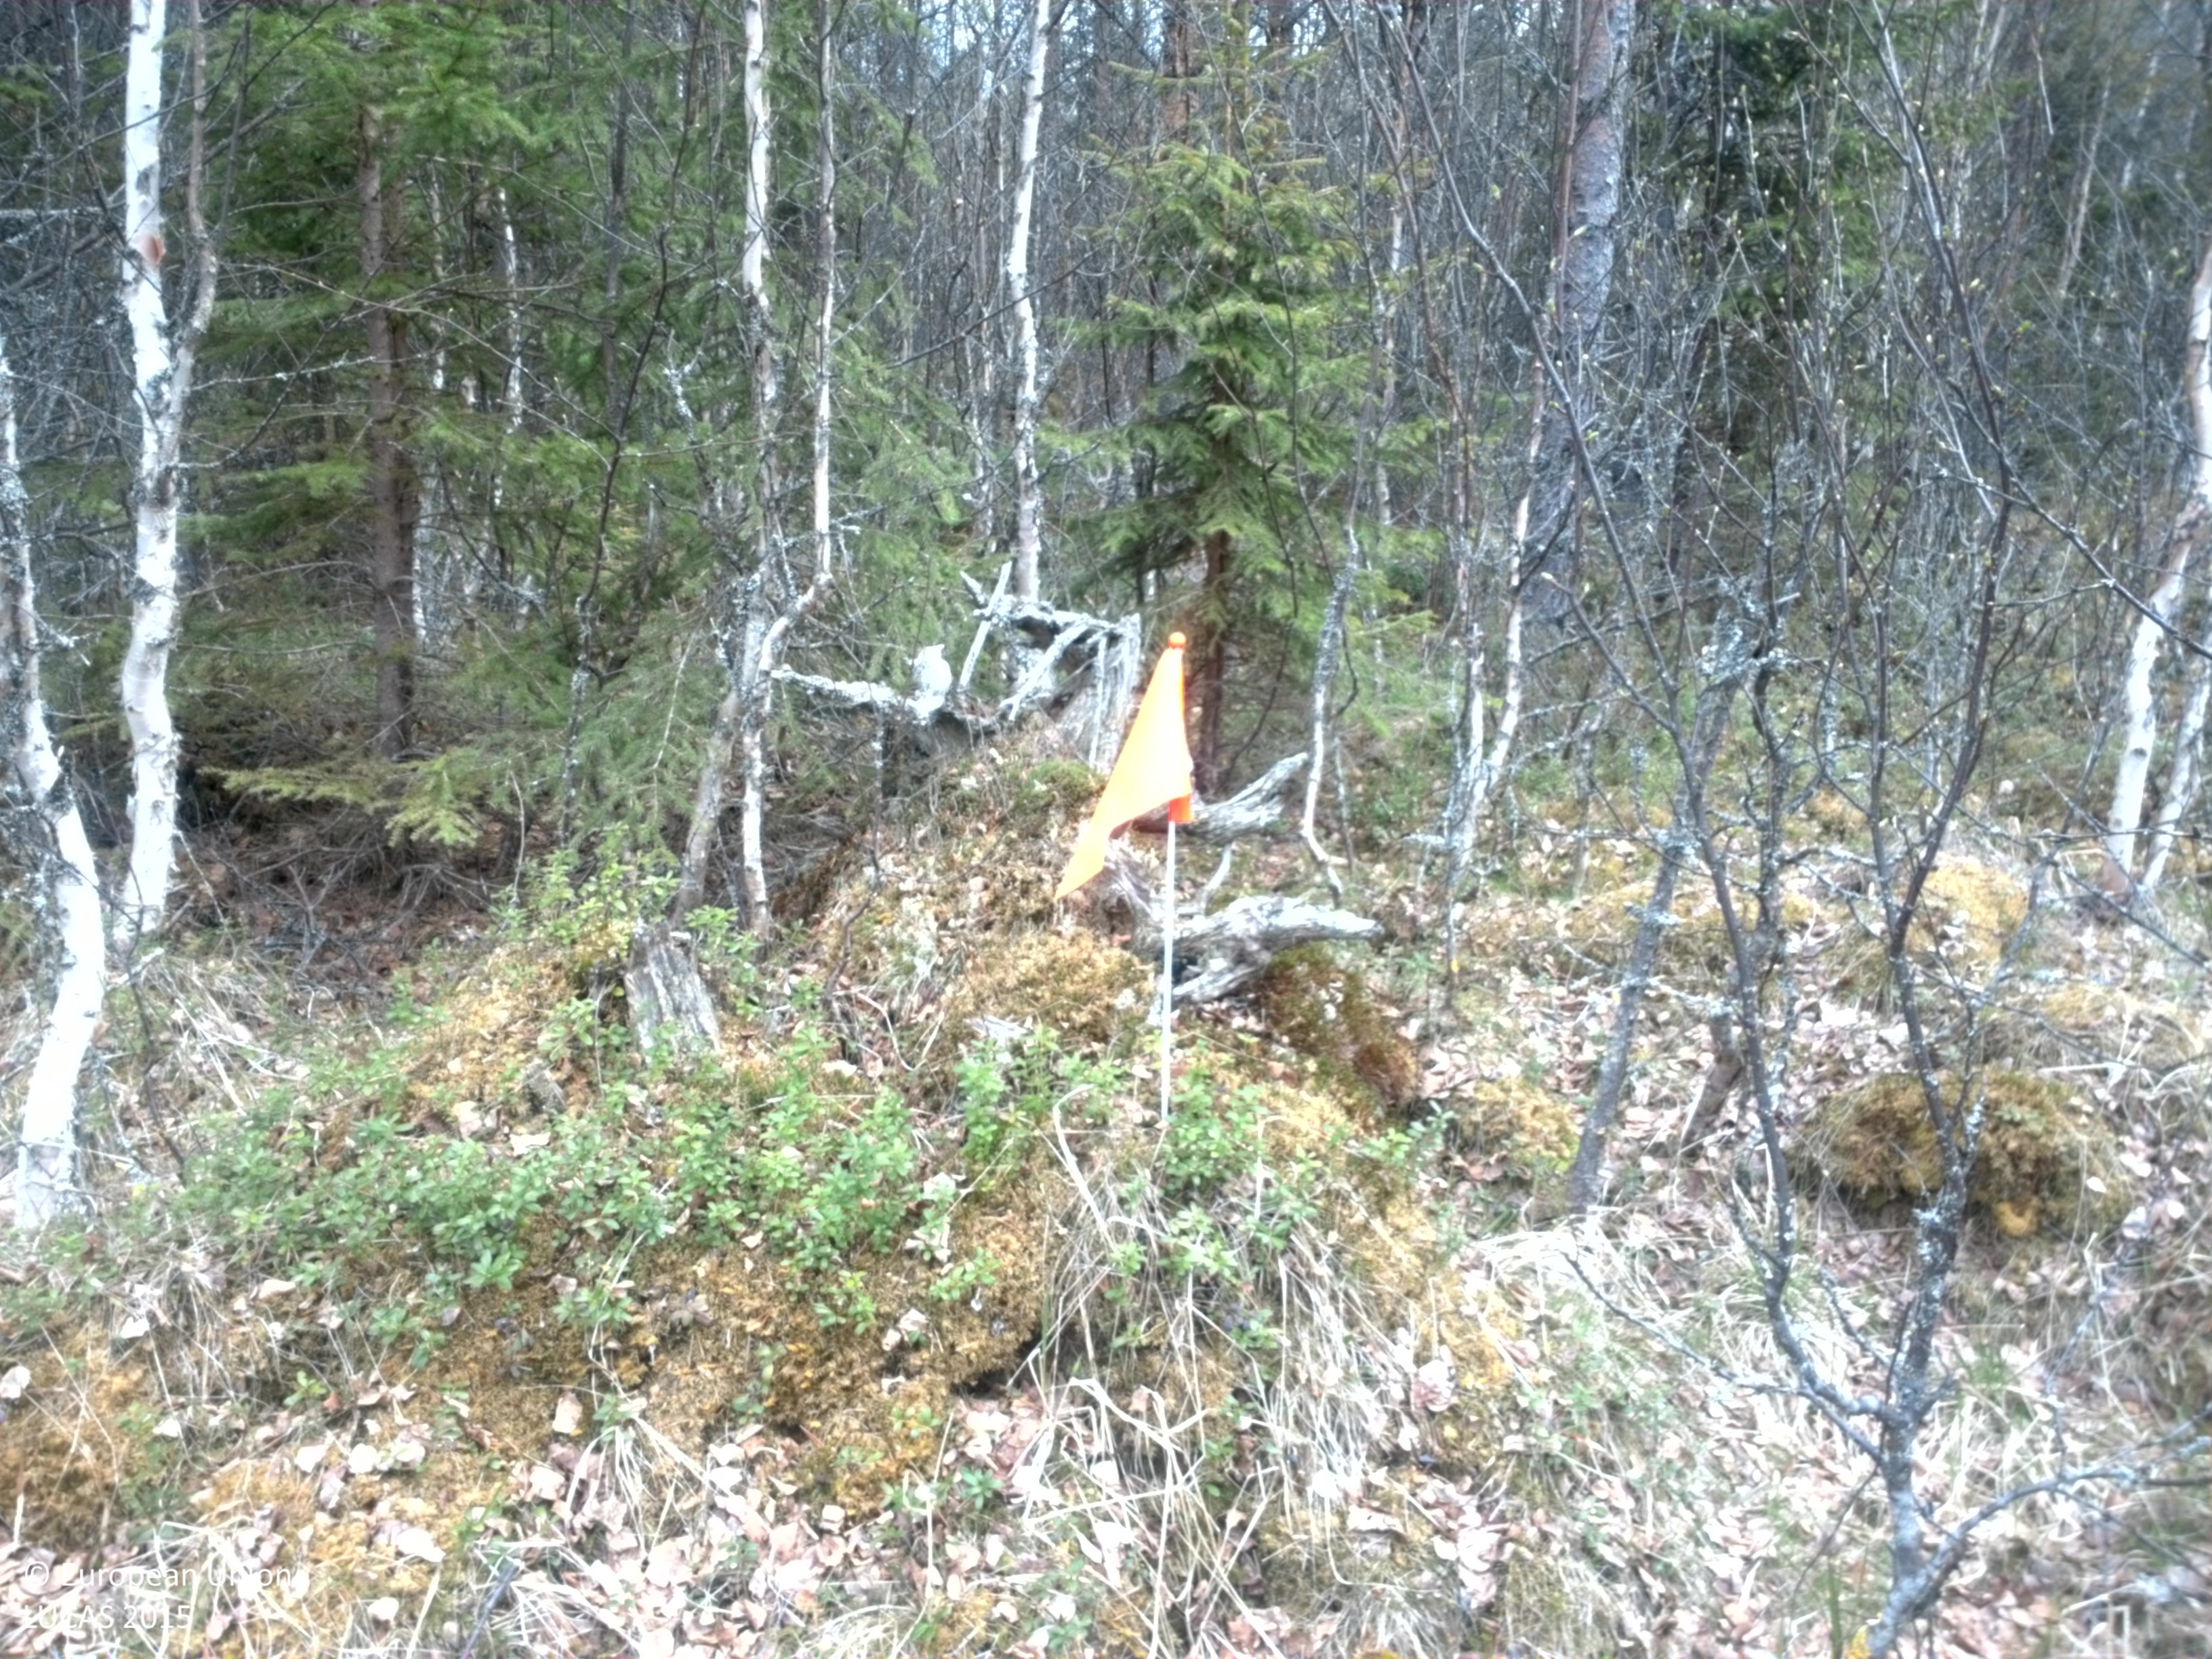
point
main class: Woodland
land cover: Other mixed woodland
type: boreal forest
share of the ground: > 75 %
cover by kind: broadleaved forest trees 40 %, coniferous forest trees 35 %, herbaceous plants 20 %, shrubs 5 %
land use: Forestry
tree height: > 5 m
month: May
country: SE
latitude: 63.3224
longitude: 15.0678
